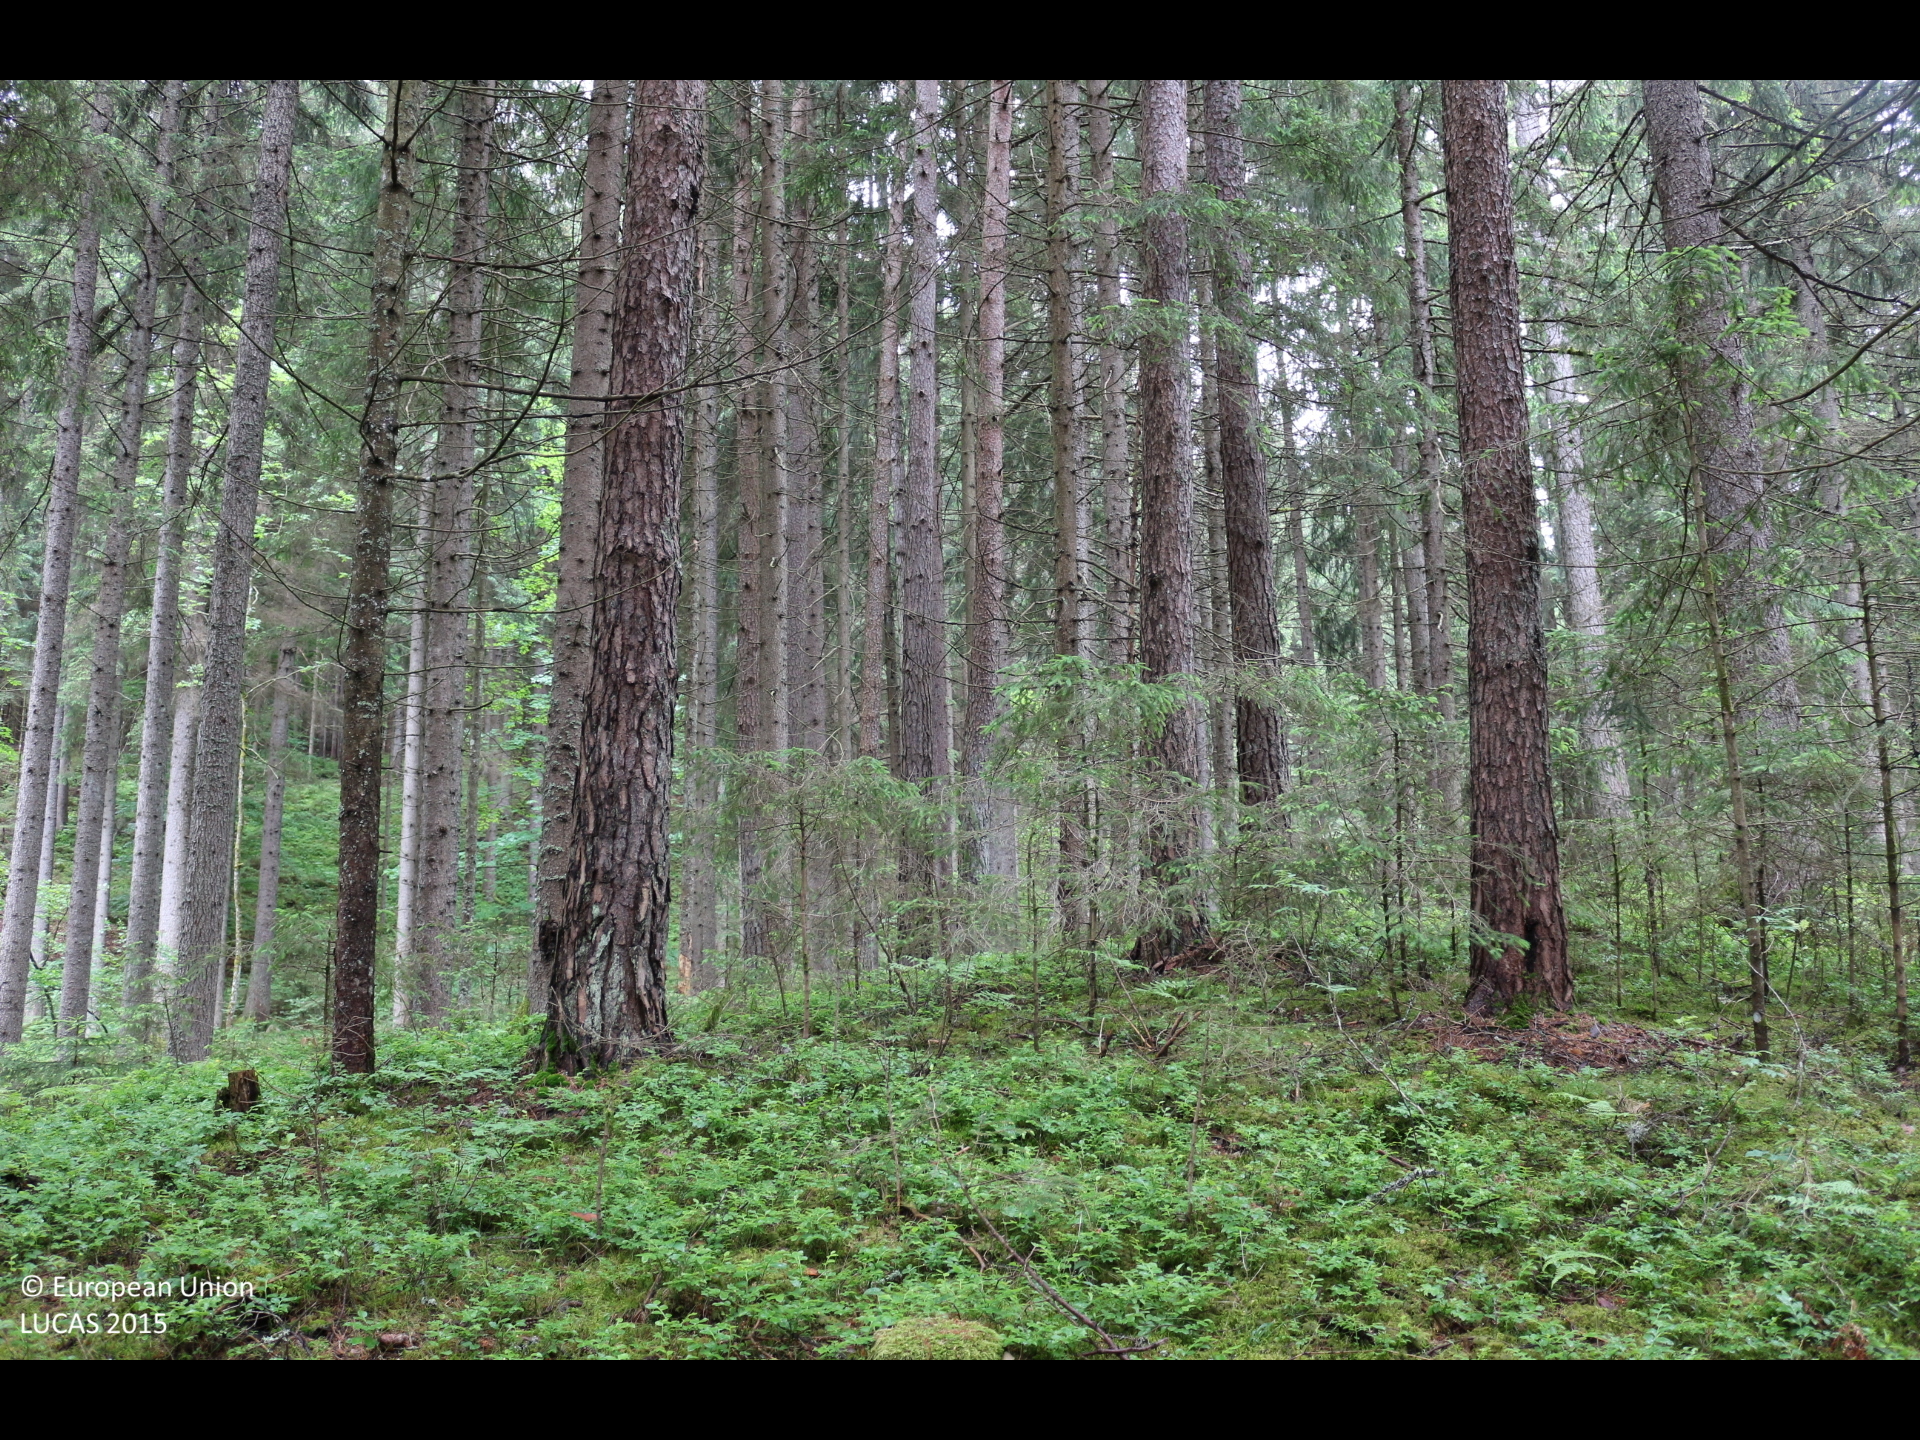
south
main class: Woodland
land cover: Spruce dominated coniferous woodland
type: alpine coniferous forest
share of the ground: > 75 %
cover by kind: coniferous forest trees 95 %, broadleaved forest trees 5 %
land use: Forestry
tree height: > 5 m
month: May
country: AT
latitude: 46.6868
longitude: 14.1161
